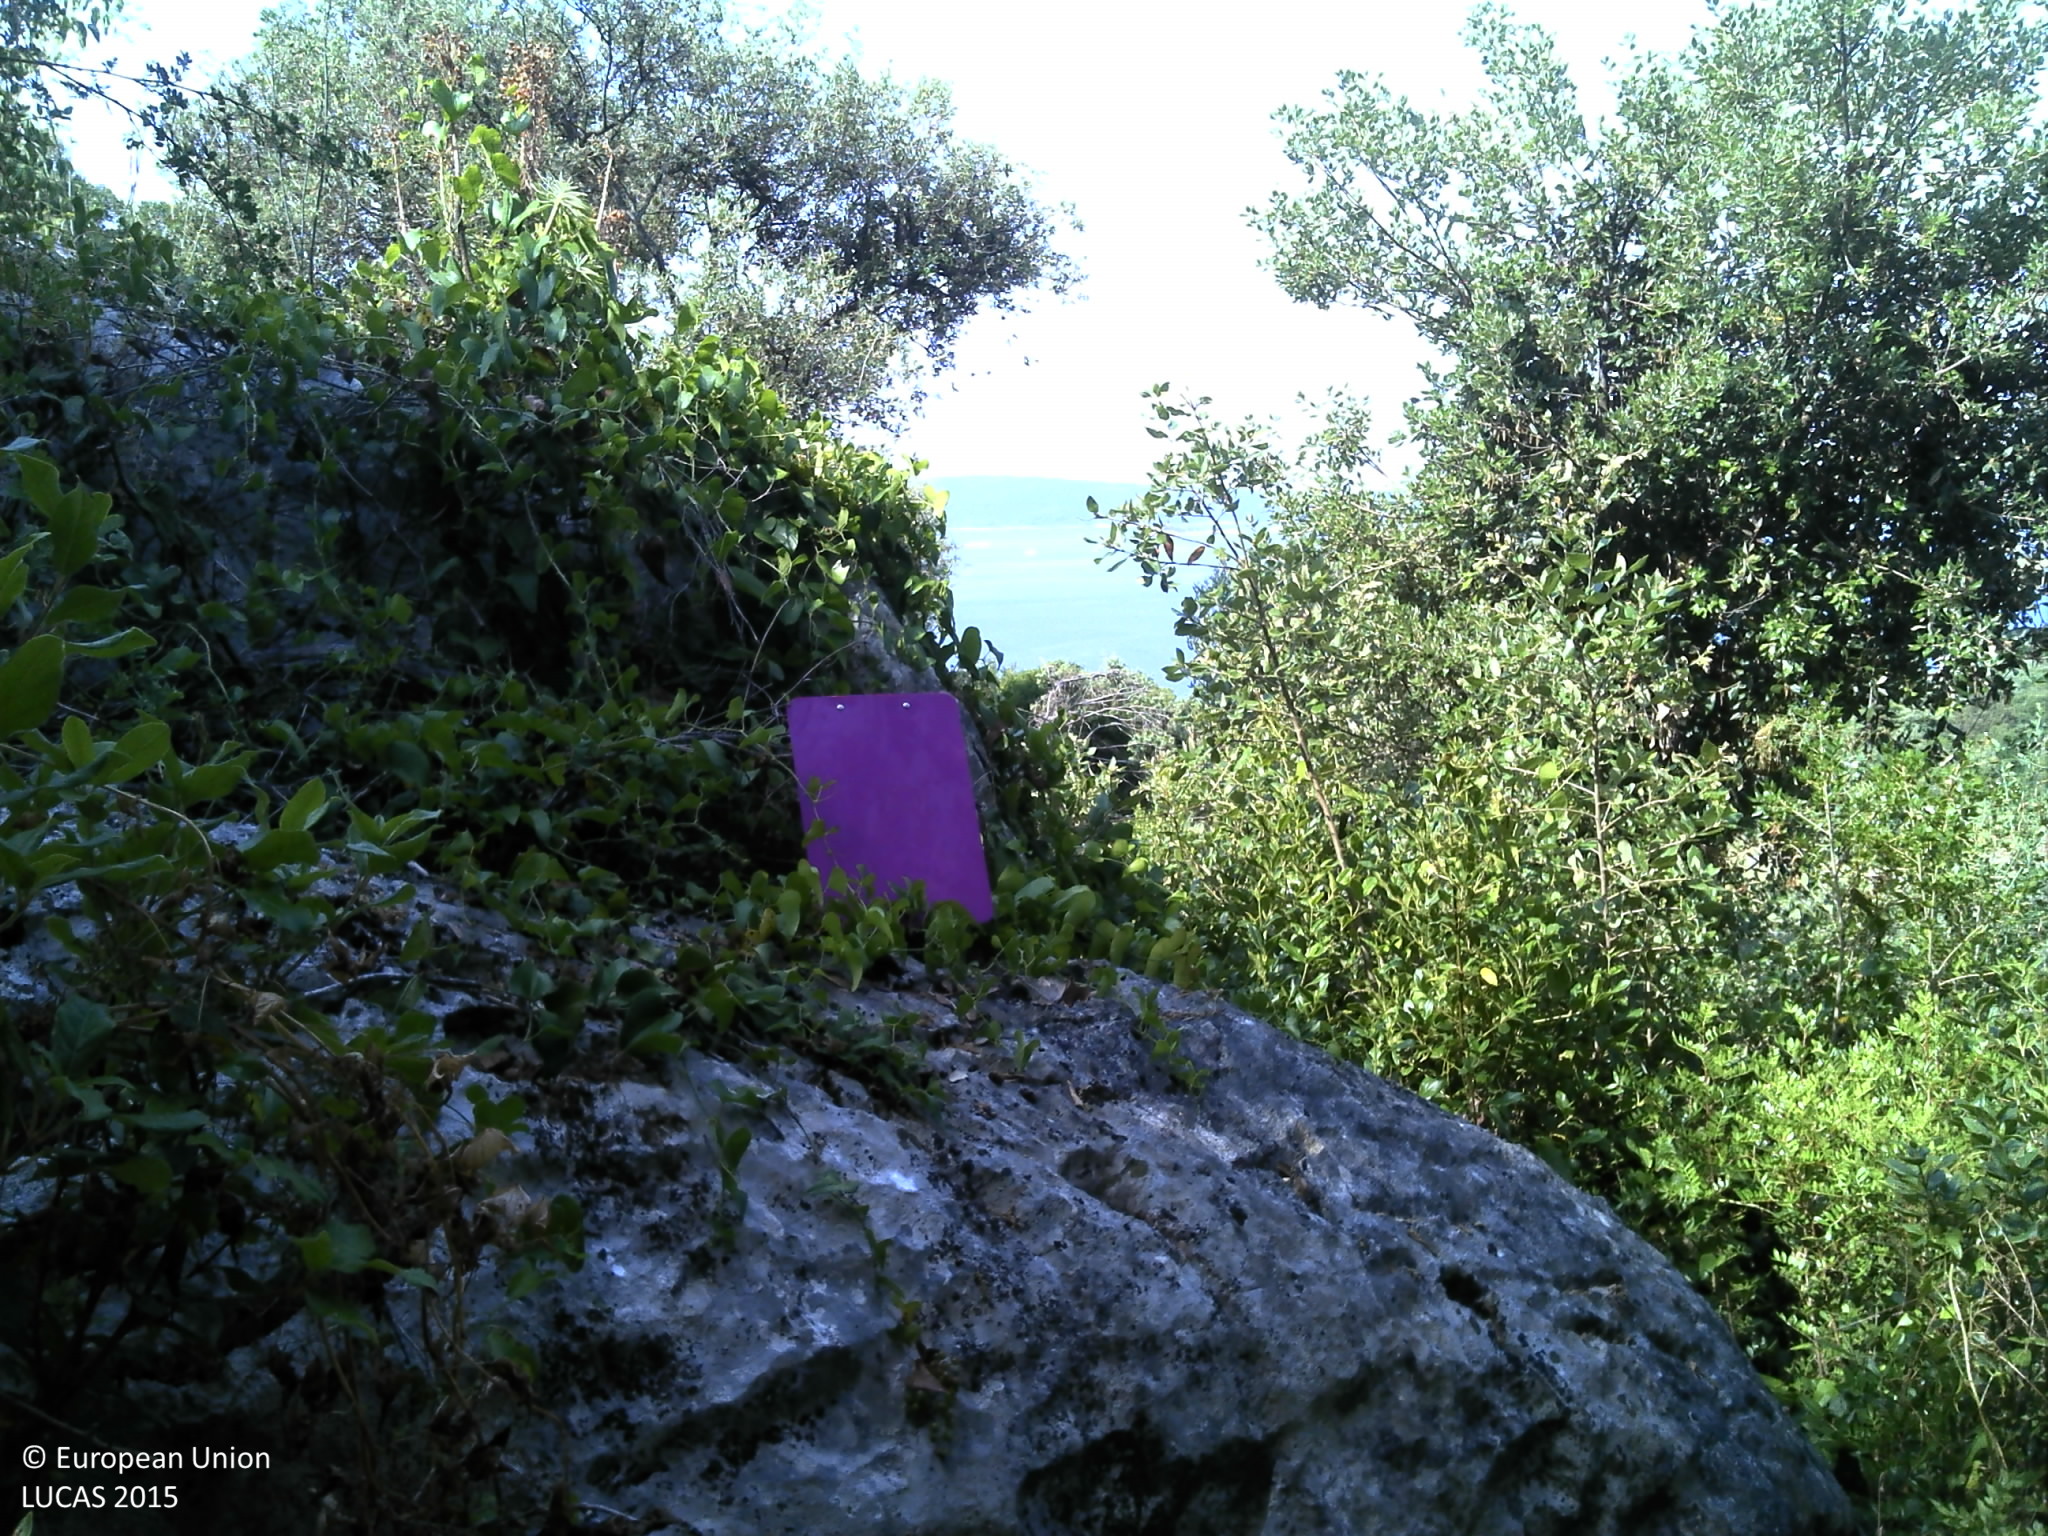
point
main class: Woodland
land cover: Broadleaved woodland
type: thermophilous deciduous forest
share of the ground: 25 - 50 %
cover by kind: broadleaved forest trees 40 %, shrubs 30 %, consolidated bare surface 20 %, unconsolidated bare surface 10 %
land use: Semi-natural and natural areas not in use
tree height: > 5 m
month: June
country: HR
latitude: 43.4952
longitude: 16.2108
